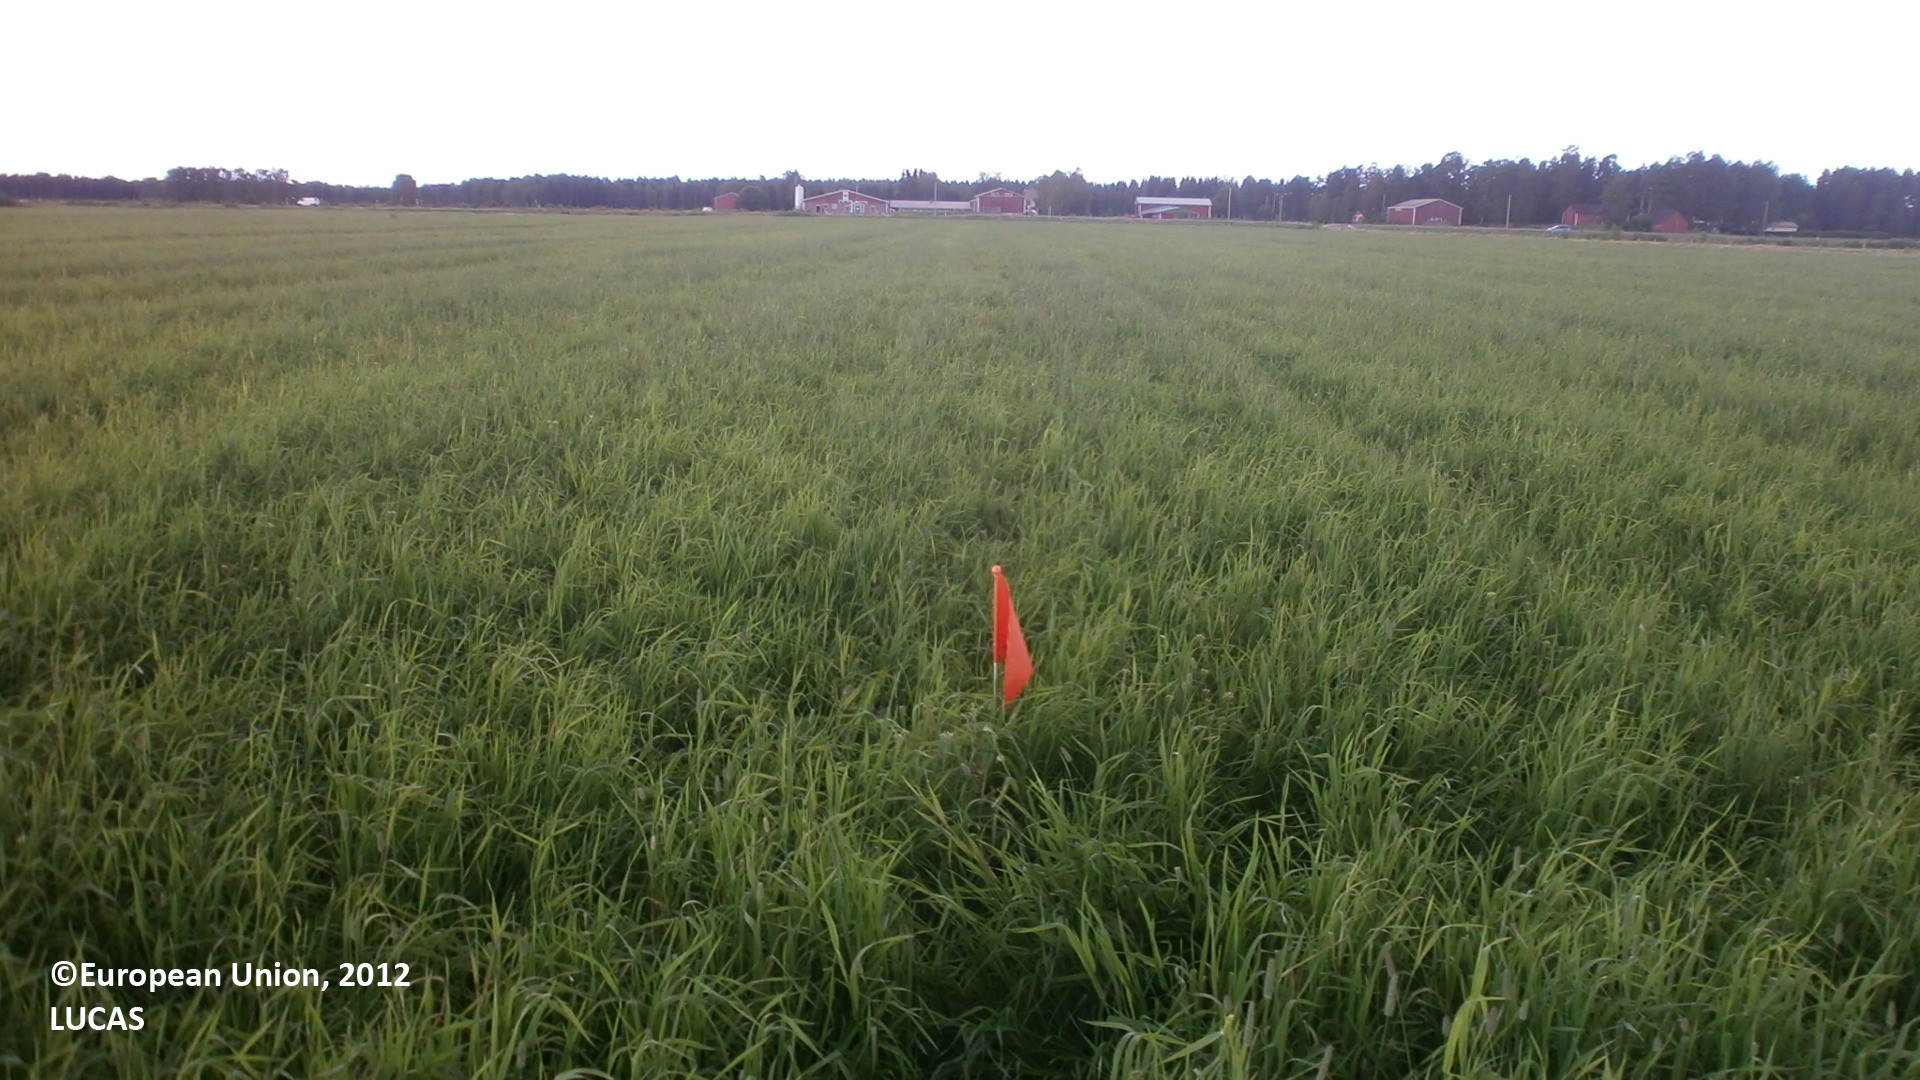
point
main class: Cropland
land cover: Temporary grasslands
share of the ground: > 75 %
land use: Agriculture (excluding fallow land and kitchen gardens)
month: July
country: FI
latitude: 64.1785
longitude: 24.2036
